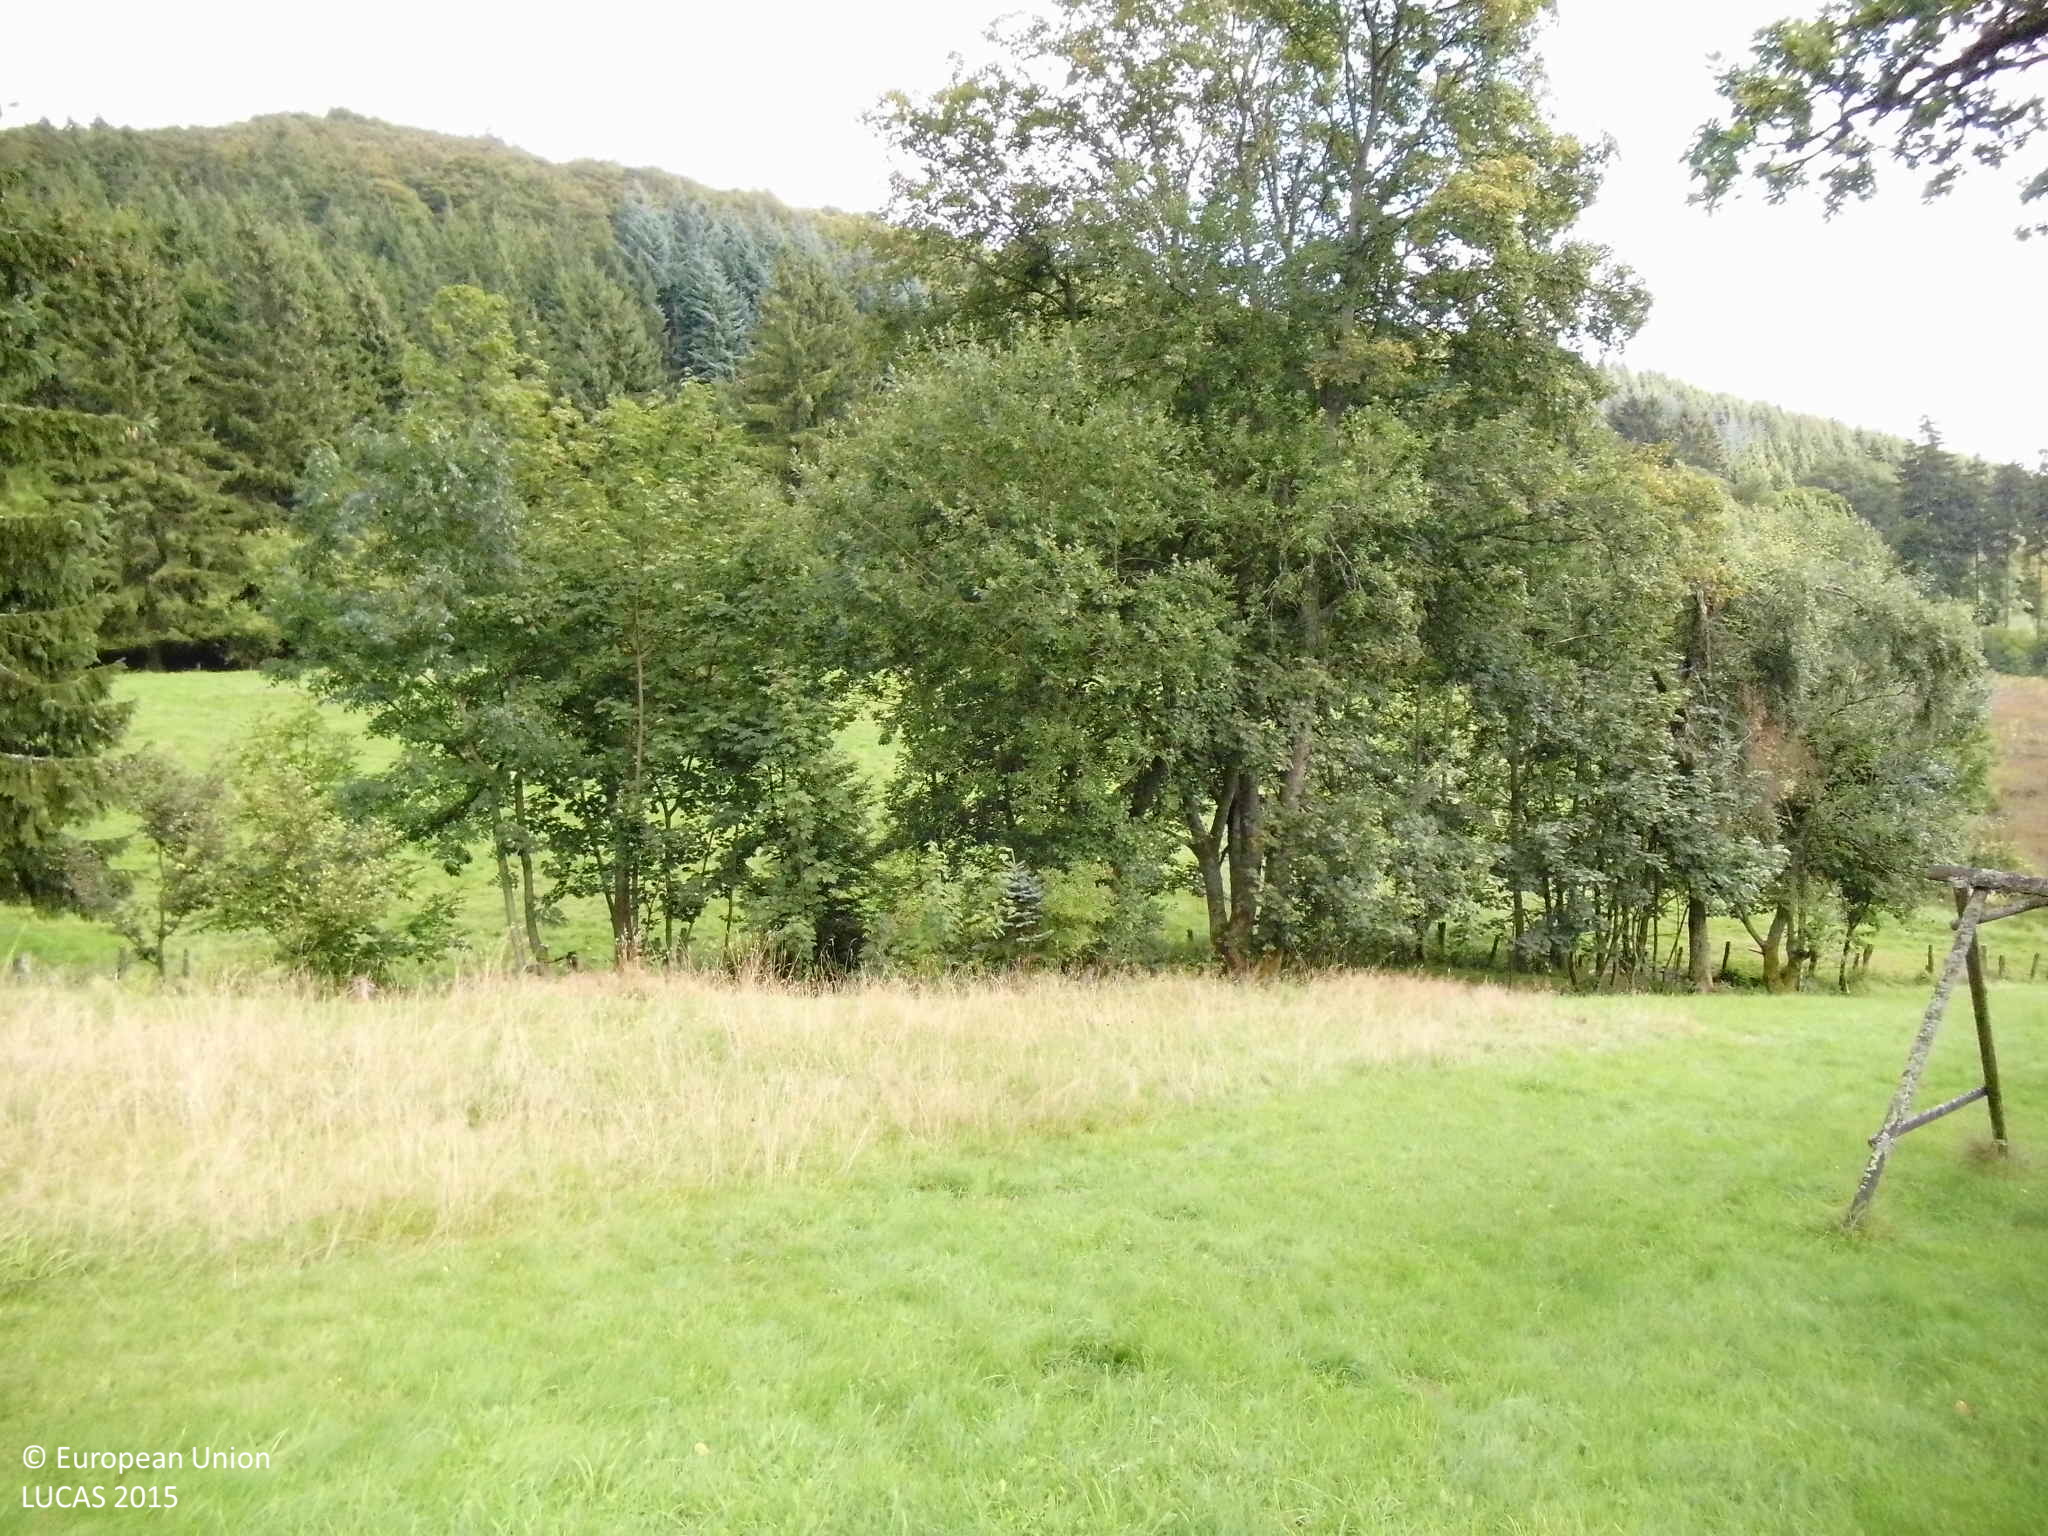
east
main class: Grassland
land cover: Grassland without tree/shrub cover
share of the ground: > 75 %
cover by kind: herbaceous plants 100 %
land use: Agriculture (excluding fallow land and kitchen gardens)
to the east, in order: Grassland without tree/shrub cover; Fences; Grassland with sparse tree/shrub cover; Fences; Grassland without tree/shrub cover; Fences; Shrubland without tree cover; Fences; Grassland without tree/shrub cover; Fences; Broadleaved woodland; Spruce dominated coniferous woodland; Broadleaved woodland; Shrubland without tree cover; Lines of trees; Paved roads, cycling and walking lanes; Grass margins; Ditches and canals; Shrubland with sparse tree cover; Groves; Spruce dominated coniferous woodland
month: September
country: DE
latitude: 51.2188
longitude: 8.6116
